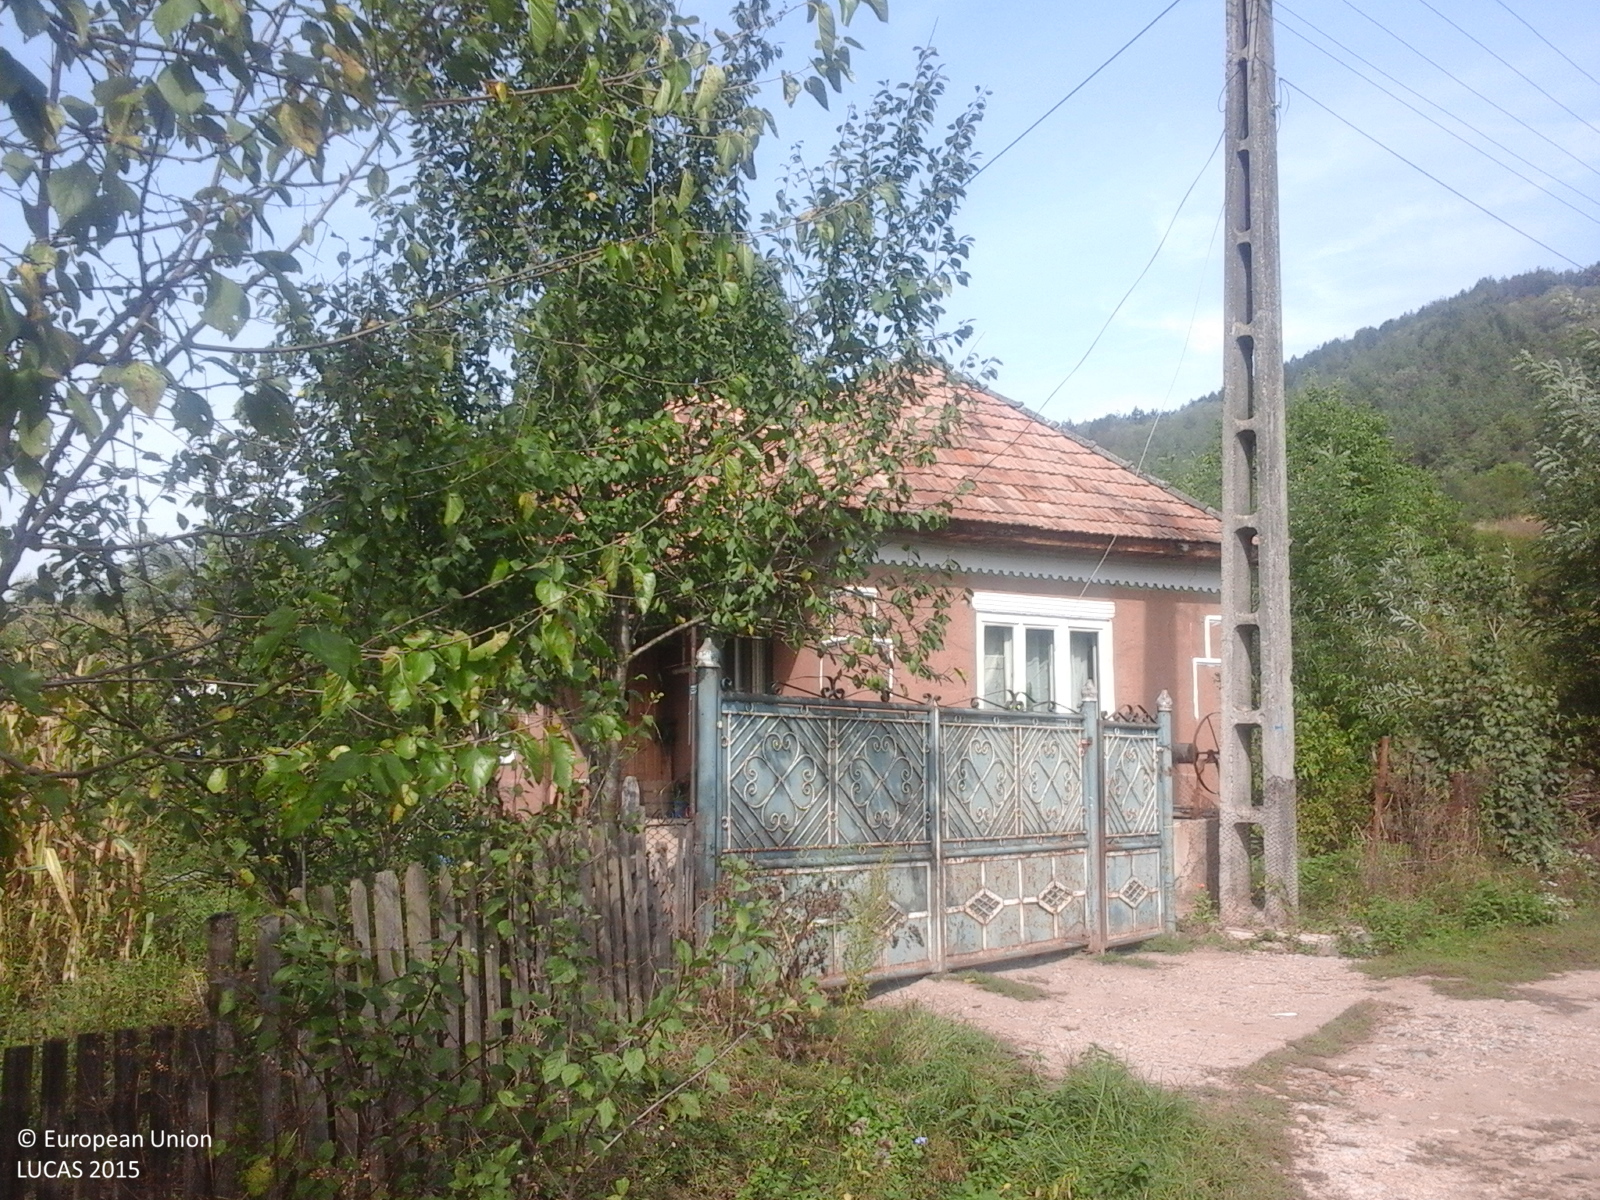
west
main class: Cropland
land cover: Maize
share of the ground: > 75 %
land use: Kitchen garden
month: September
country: RO
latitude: 47.1052
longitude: 23.2842
